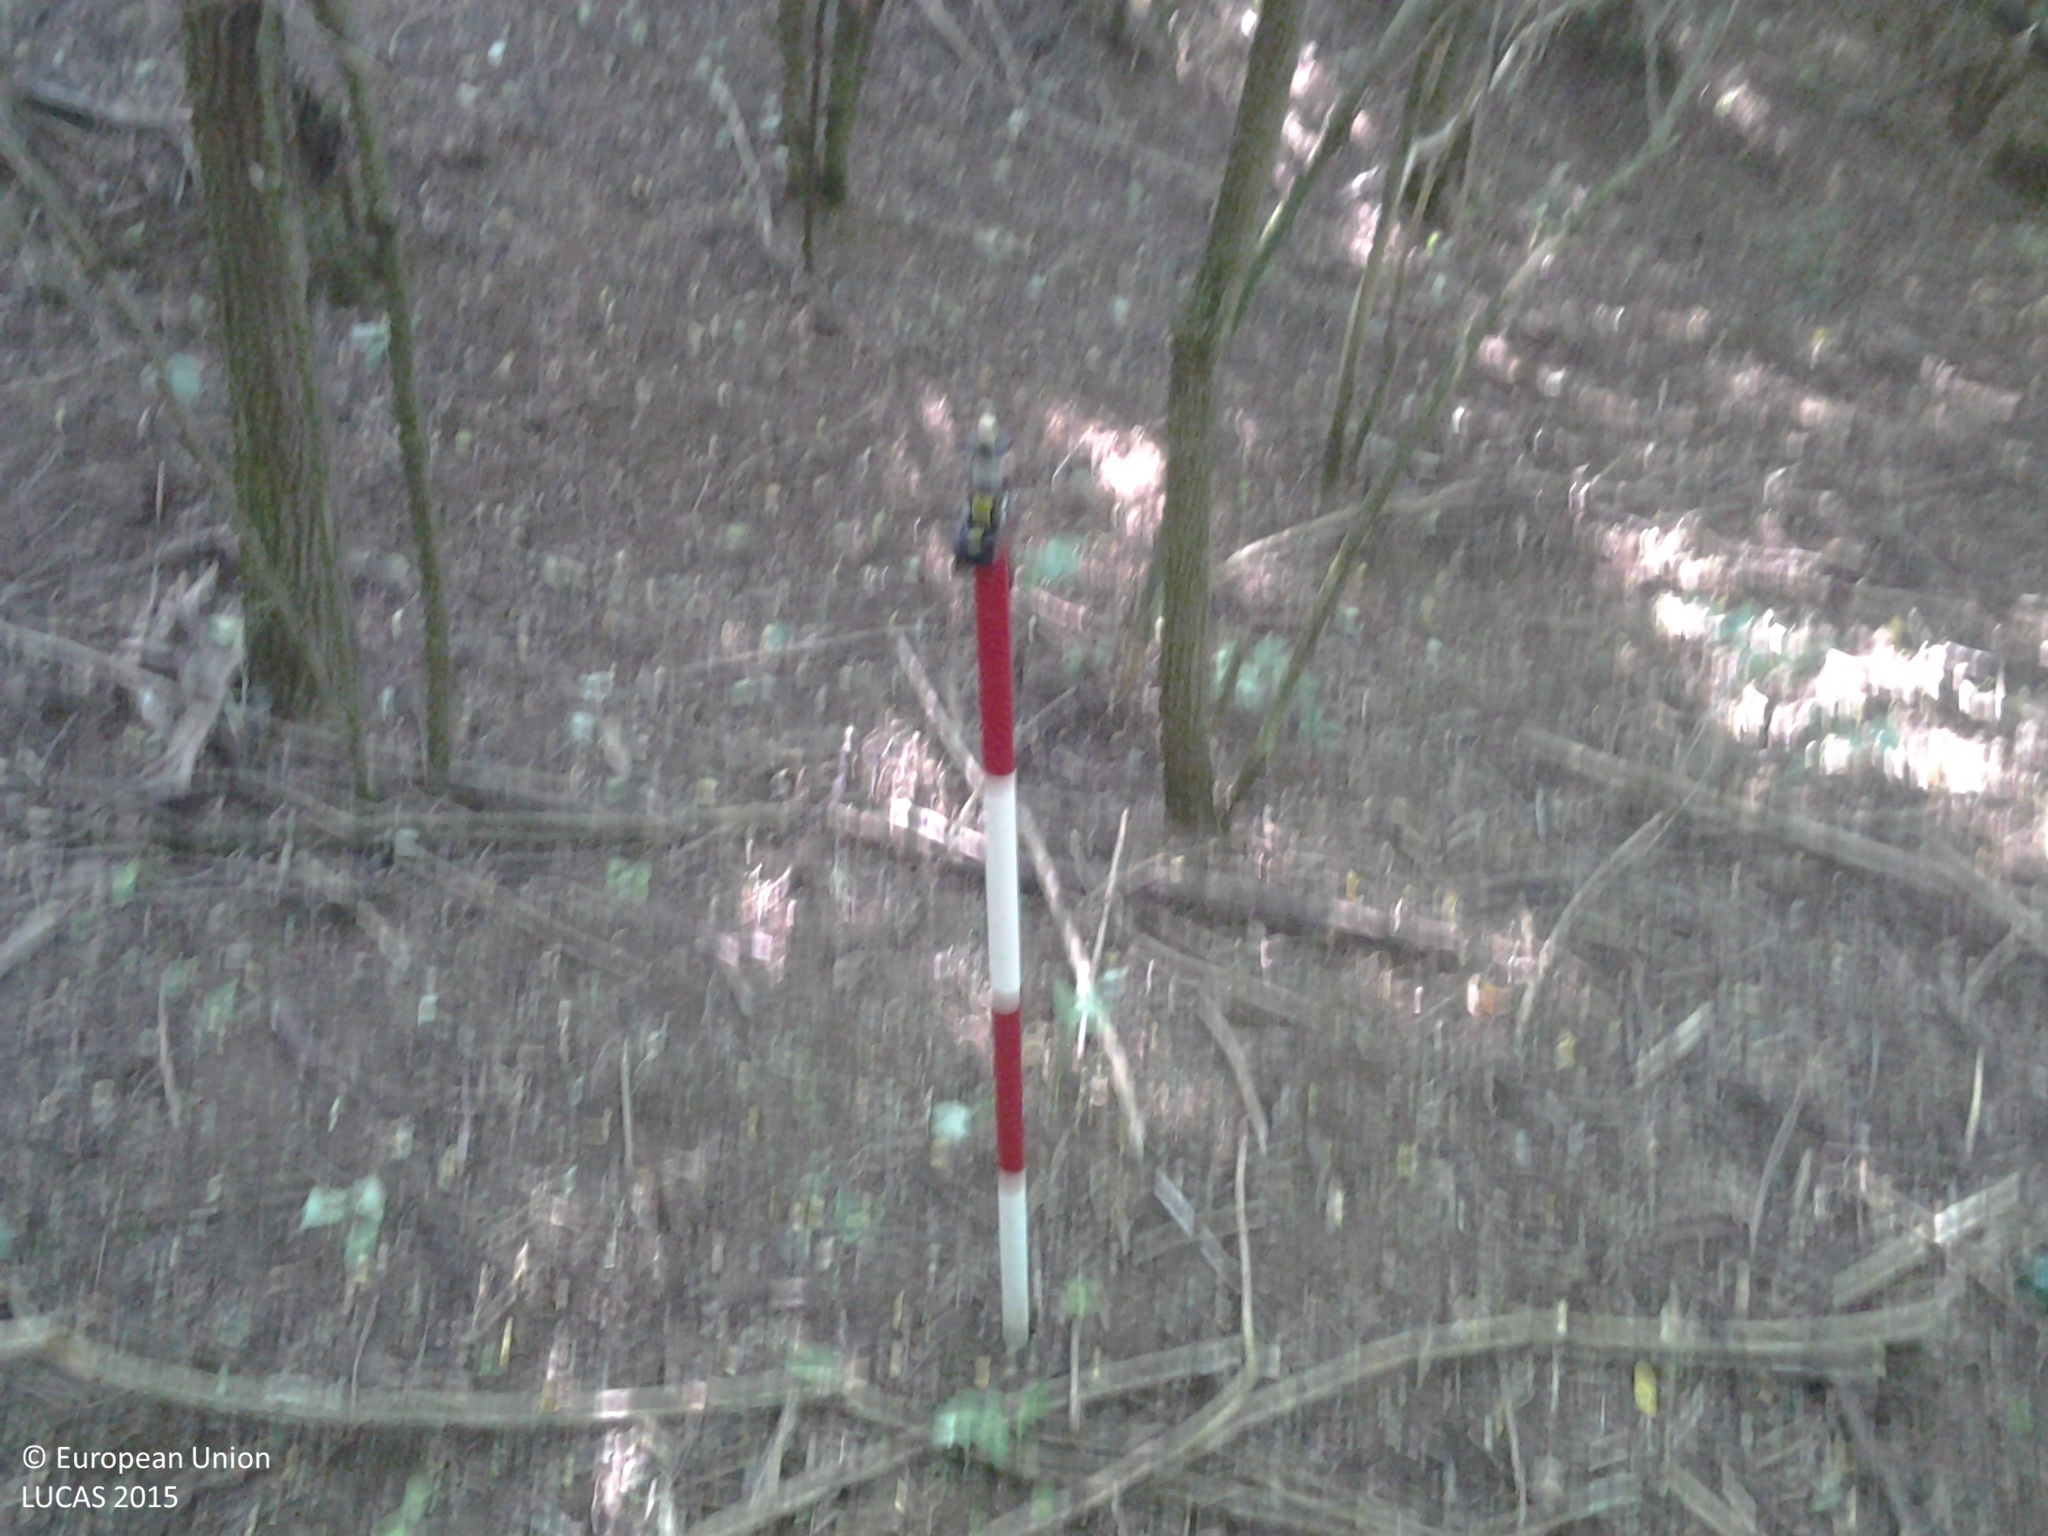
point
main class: Woodland
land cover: Broadleaved woodland
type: mesophytic deciduous forest
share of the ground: > 75 %
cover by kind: broadleaved forest trees 80 %, shrubs 20 %
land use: Forestry
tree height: > 5 m
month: August
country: HU
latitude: 48.0095
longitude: 19.9337
